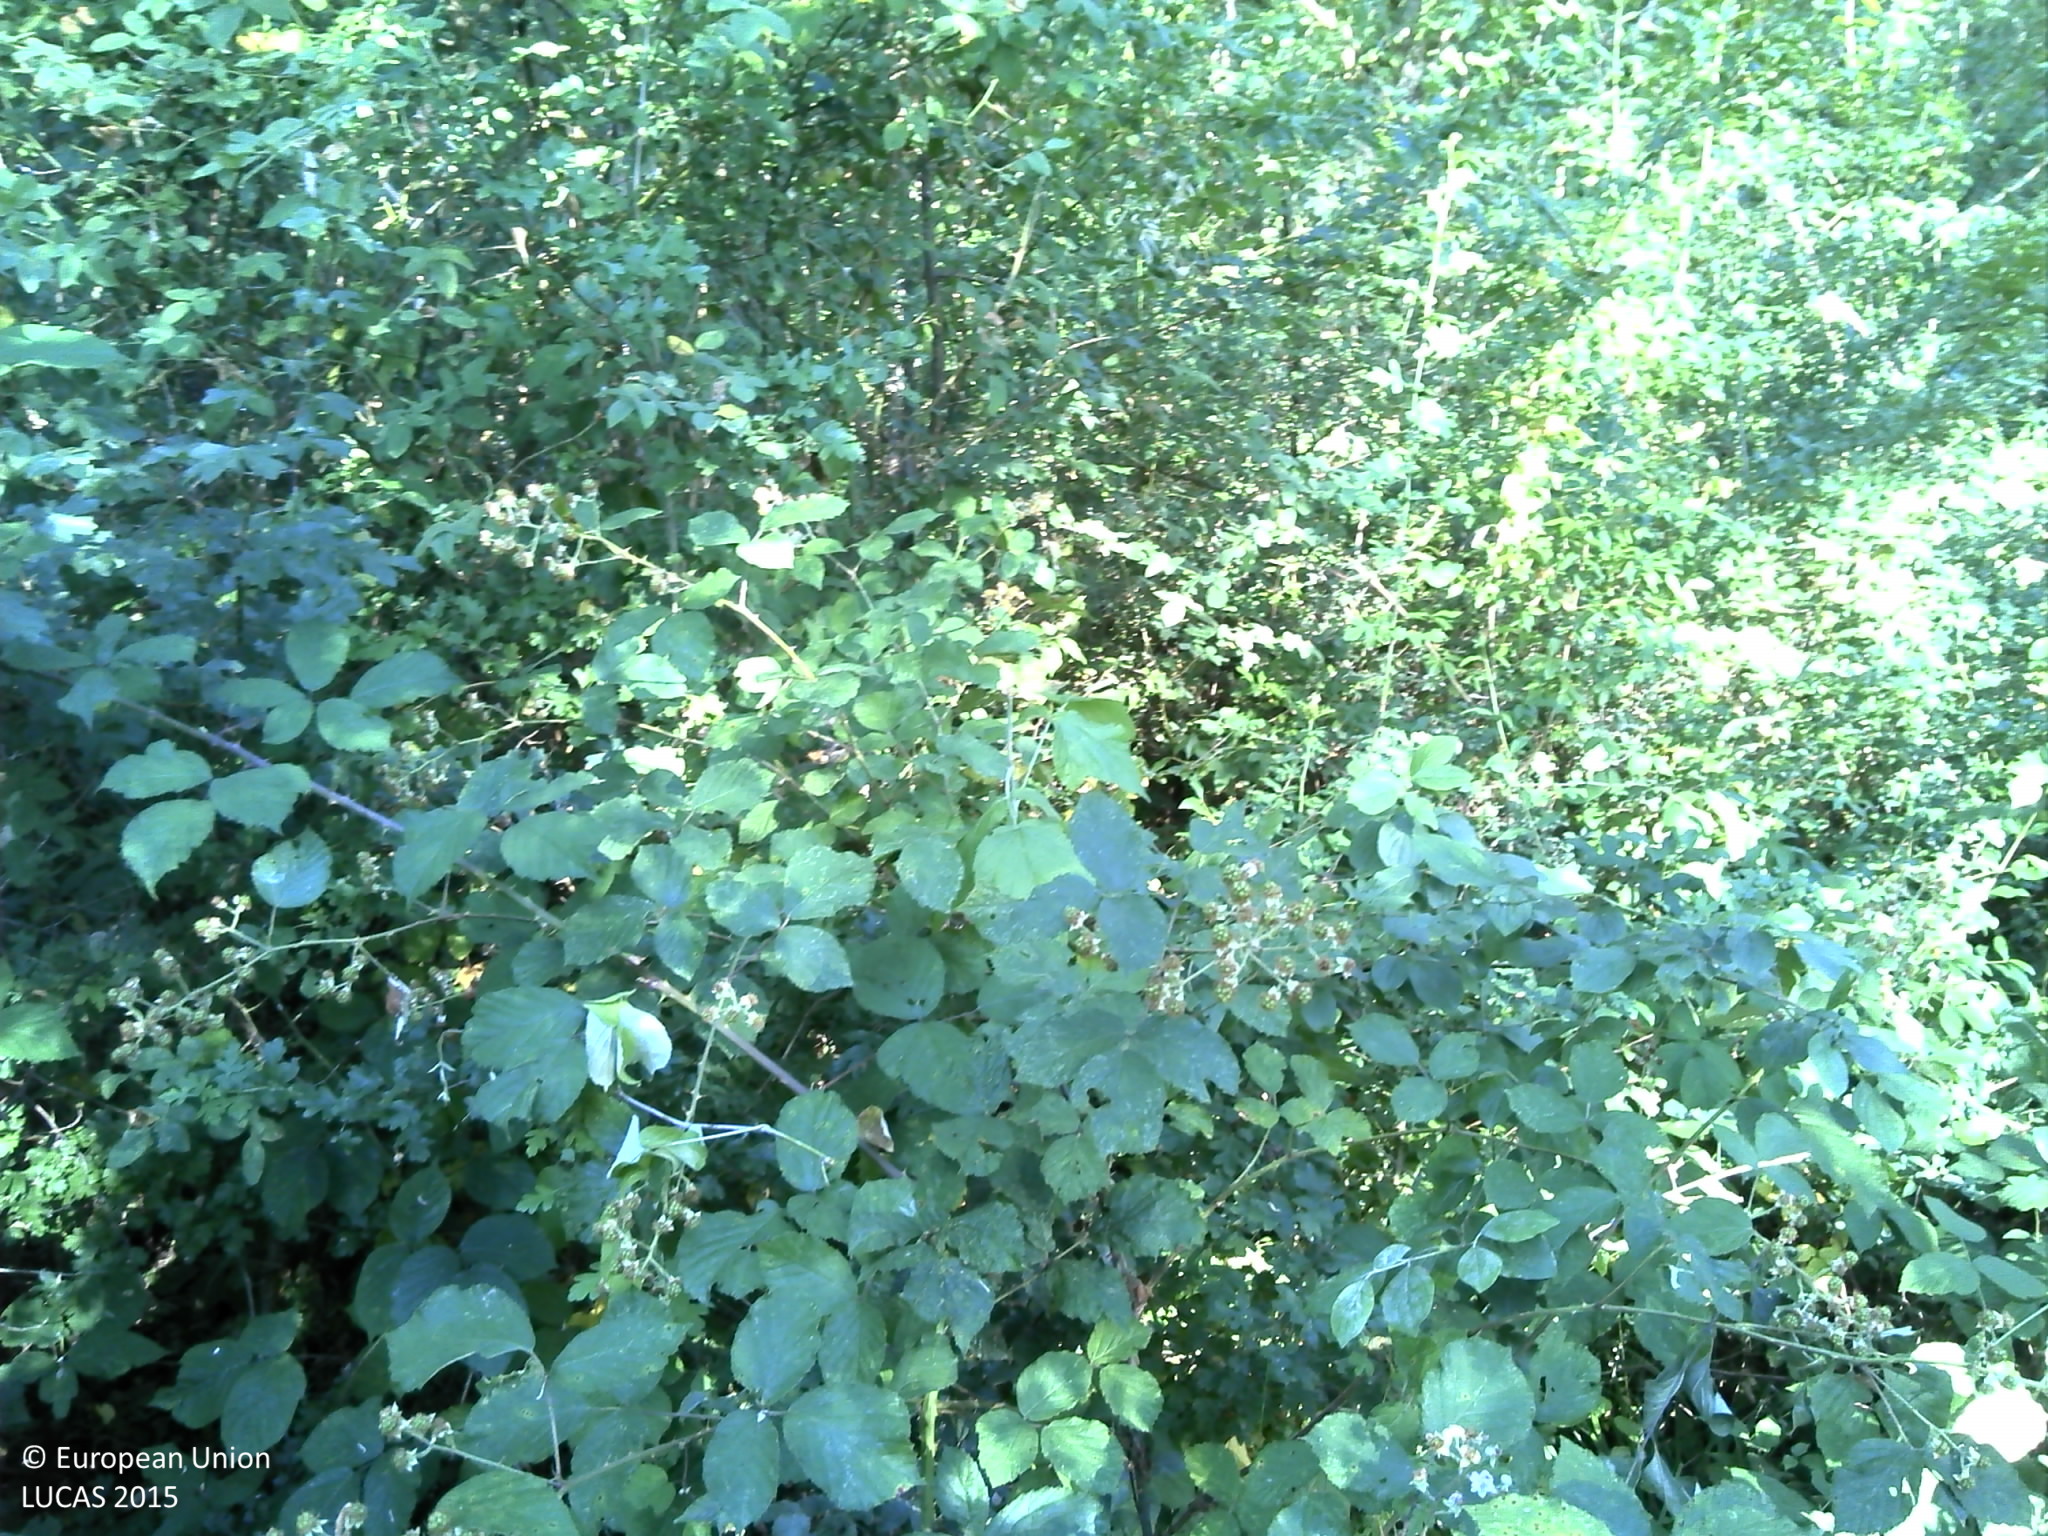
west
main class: Woodland
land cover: Broadleaved woodland
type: mesophytic deciduous forest
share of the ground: > 75 %
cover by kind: broadleaved forest trees 85 %, herbaceous plants 15 %
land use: Forestry
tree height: > 5 m
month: July
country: FR
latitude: 48.2639
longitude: 6.1341
